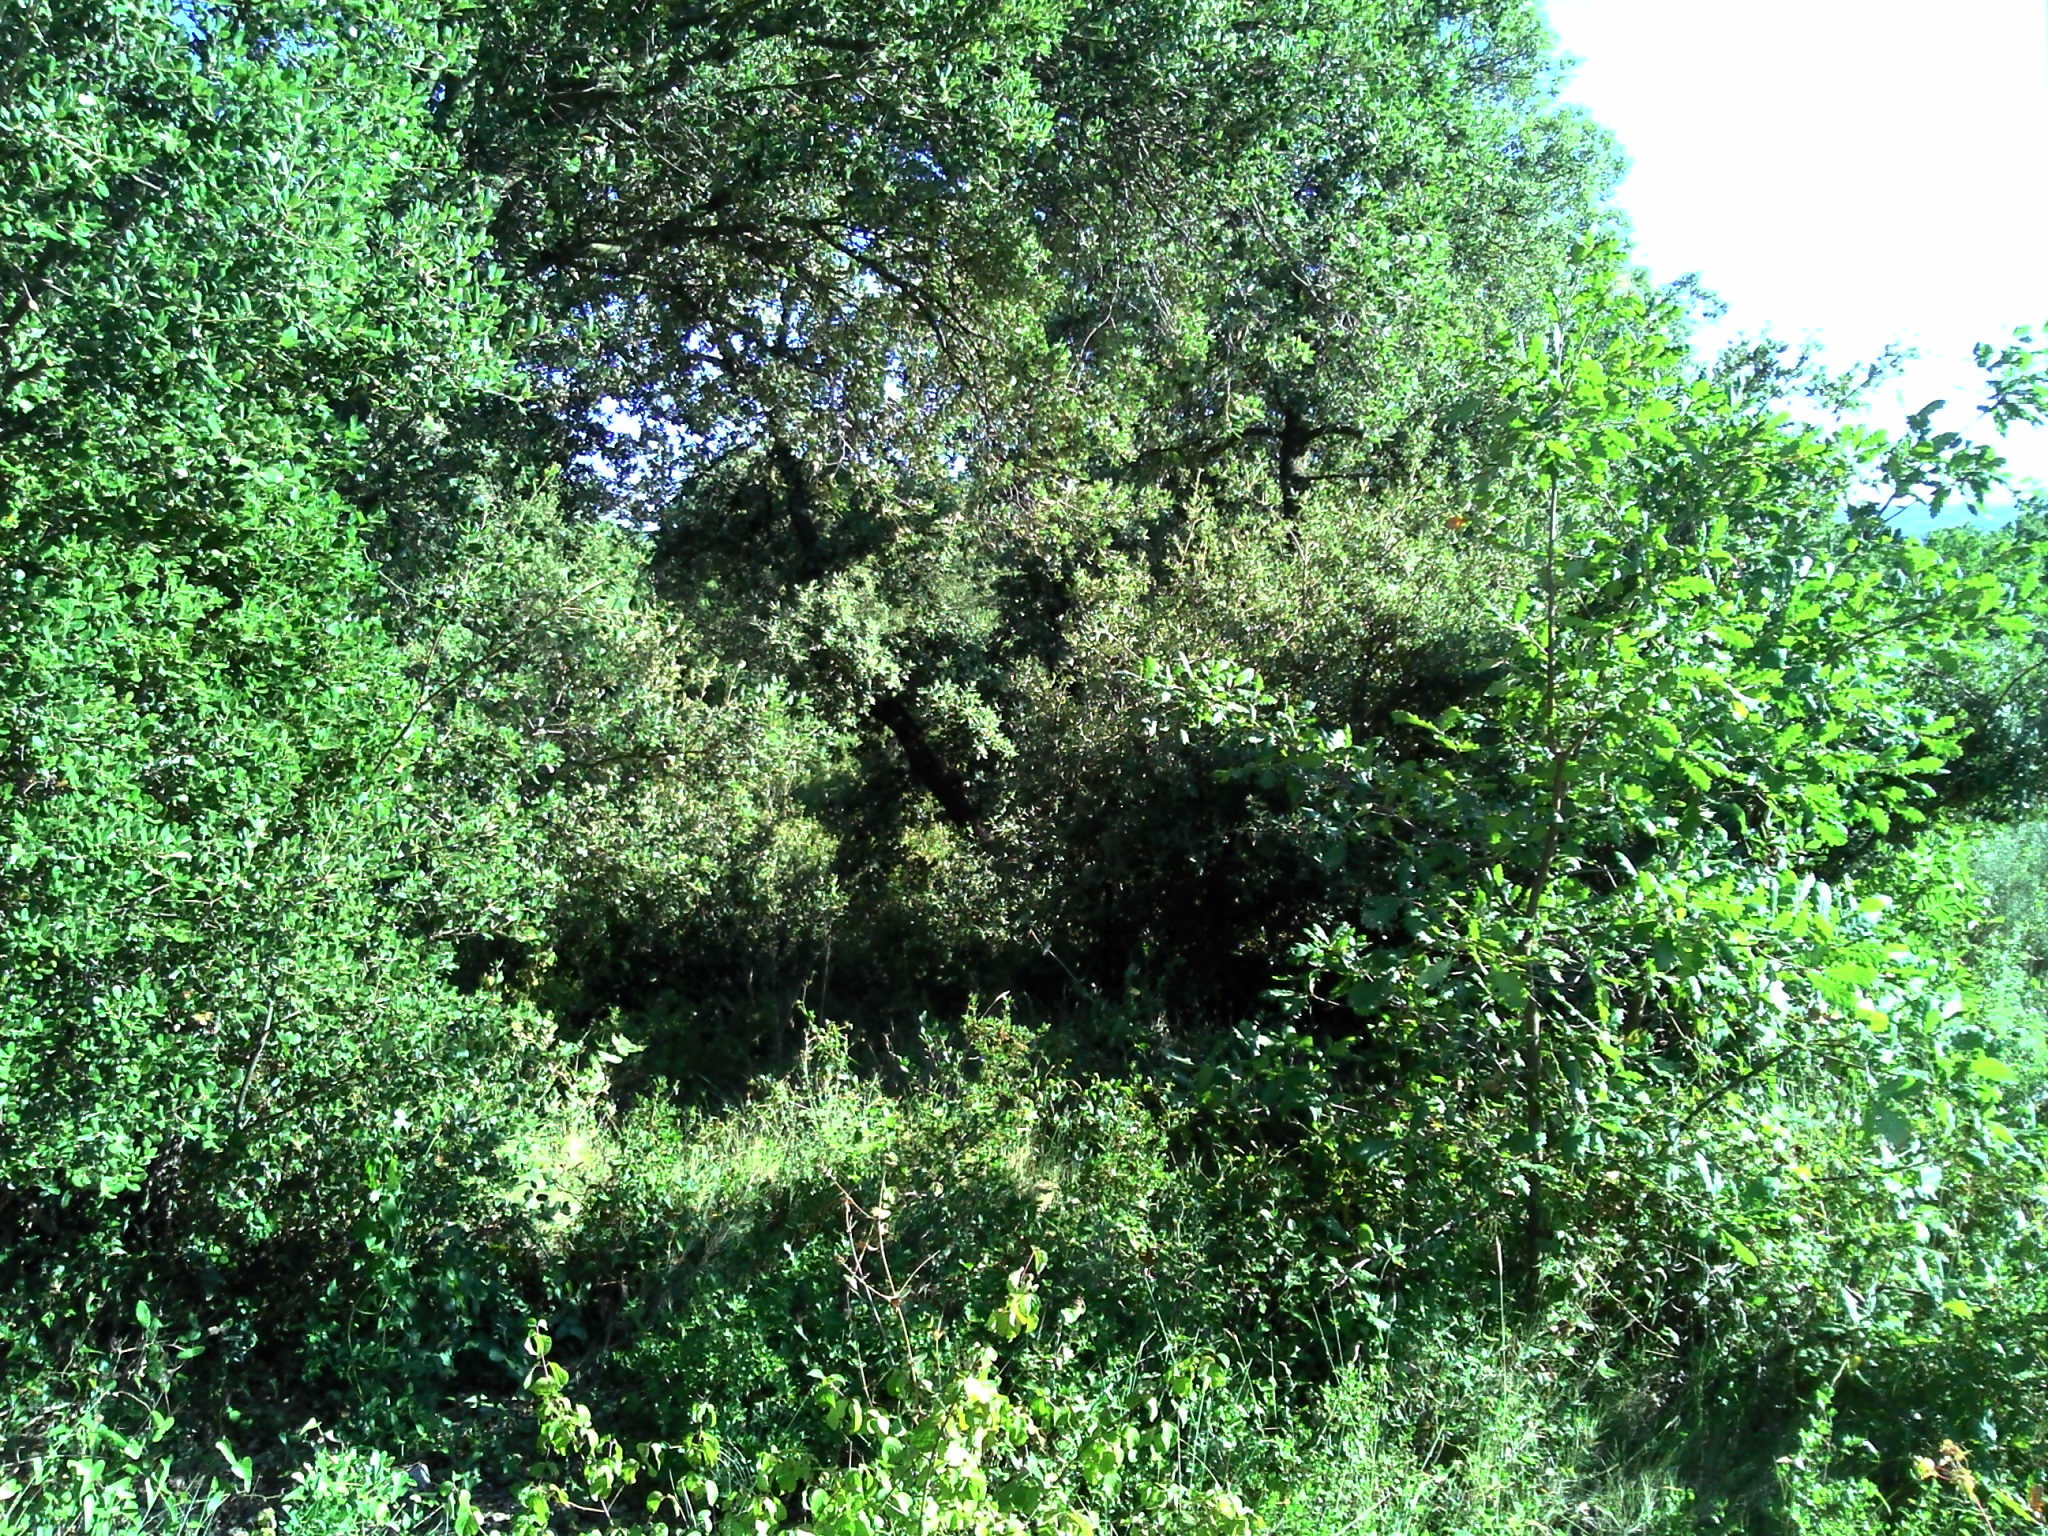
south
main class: Woodland
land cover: Broadleaved woodland
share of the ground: > 75 %
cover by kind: broadleaved forest trees 40 %, shrubs 40 %, herbaceous plants 15 %, consolidated bare surface 5 %
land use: Semi-natural and natural areas not in use
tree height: < 5 m
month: July
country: FR
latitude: 44.0135
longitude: 4.3076
